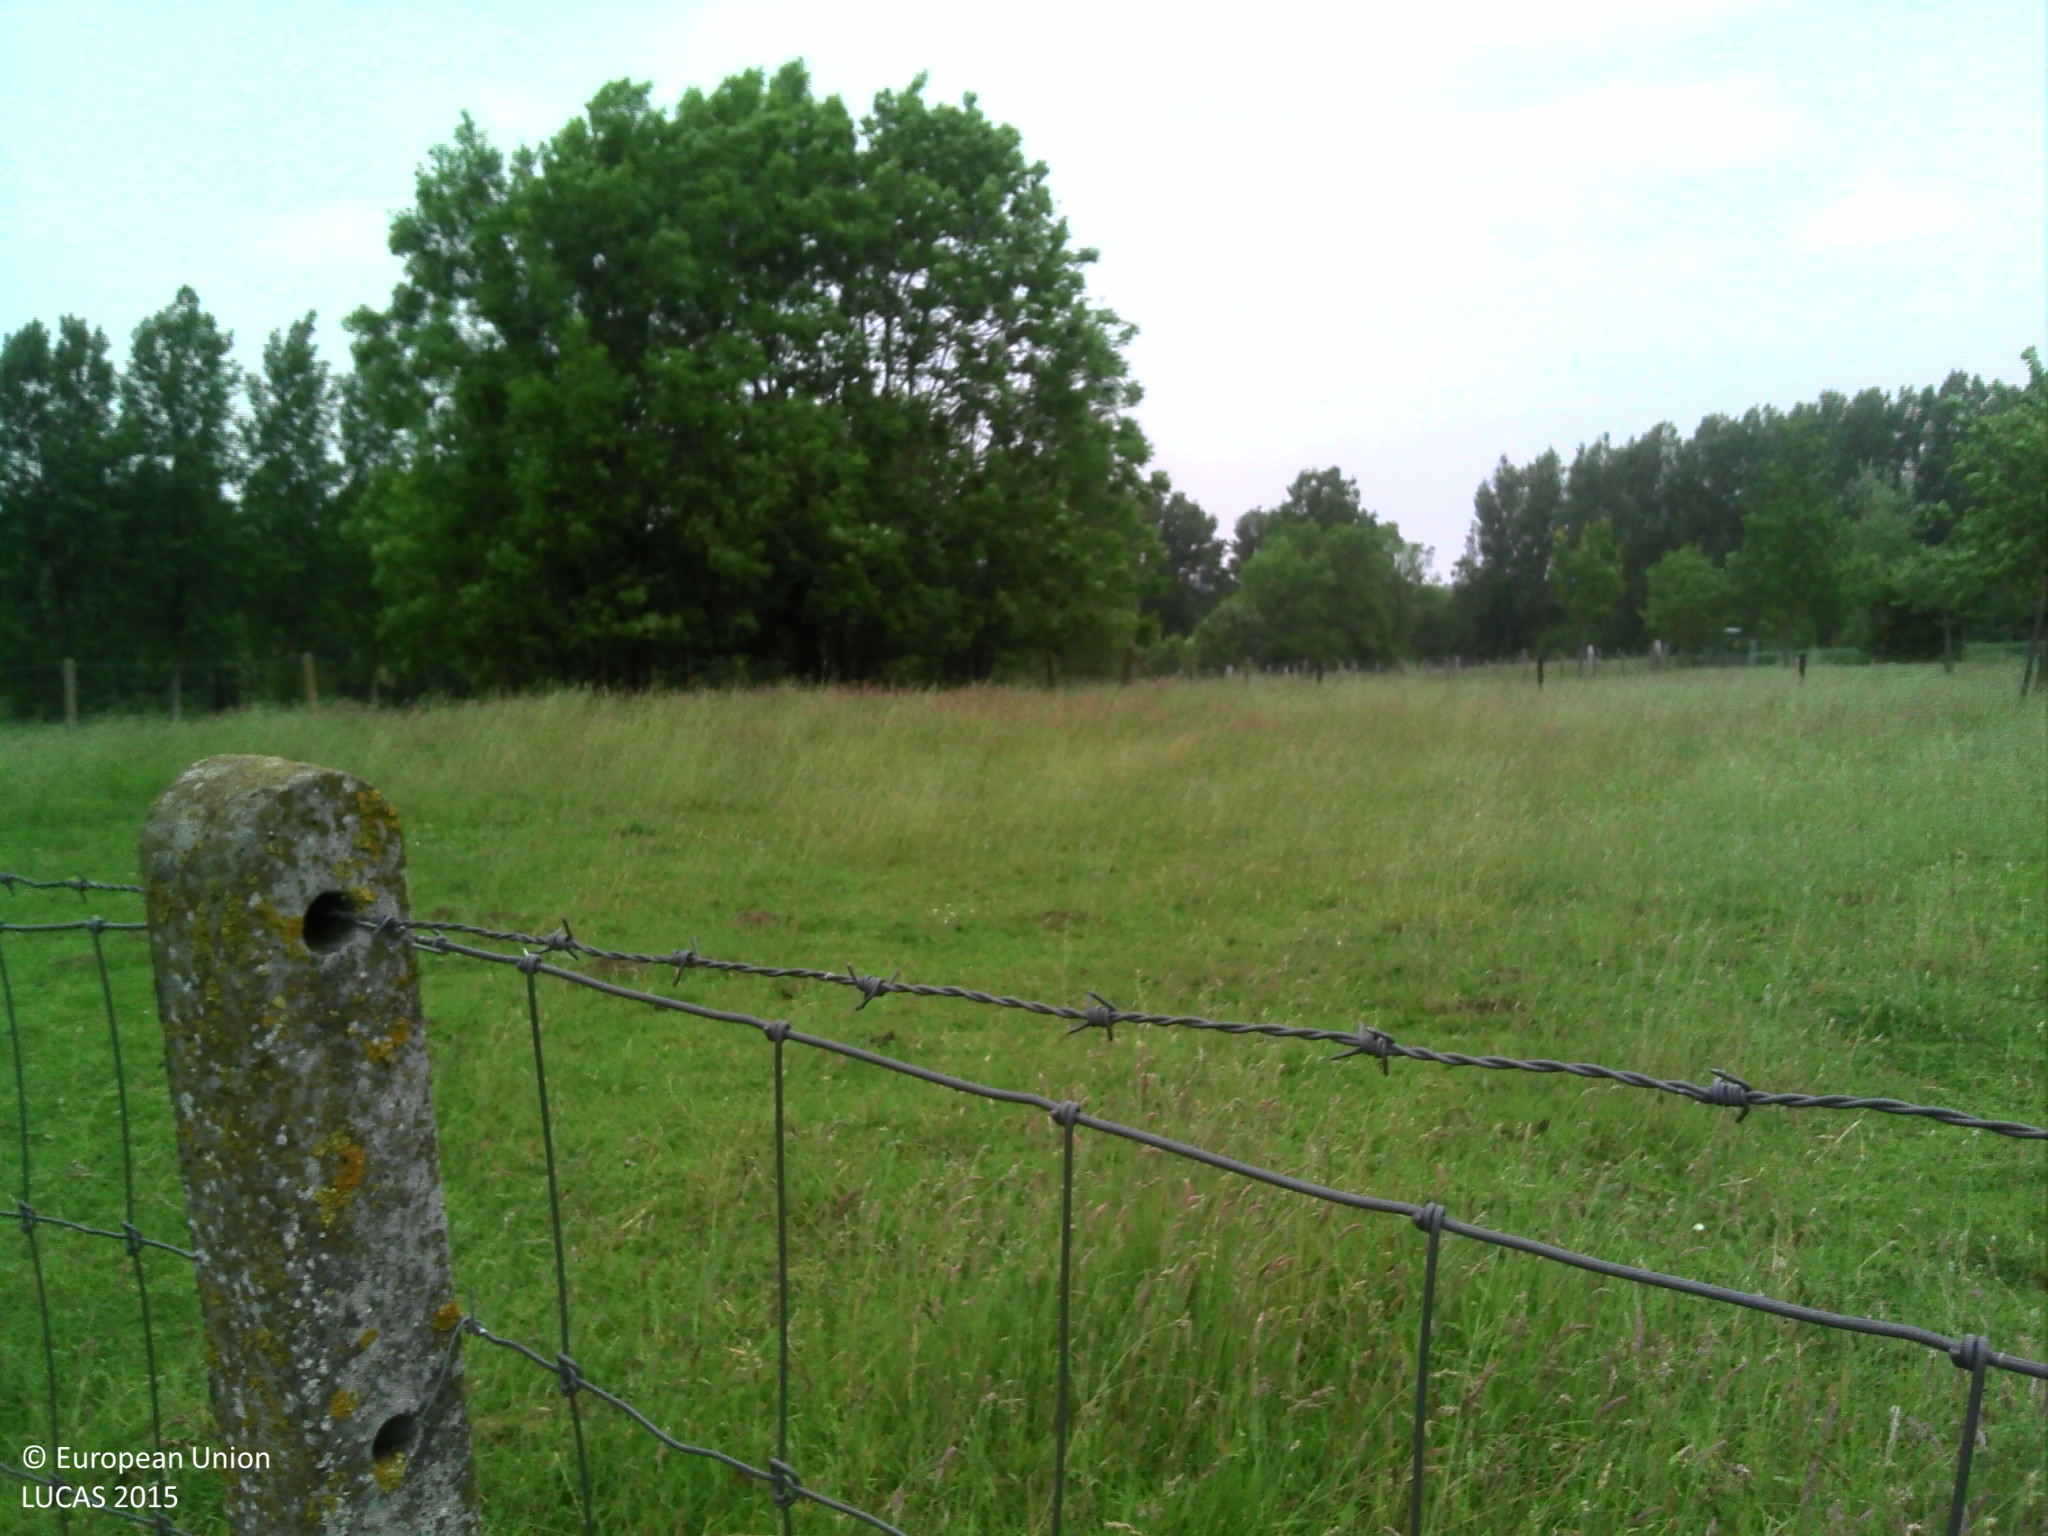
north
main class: Grassland
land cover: Grassland without tree/shrub cover
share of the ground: > 75 %
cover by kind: herbaceous plants 100 %
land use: Residential
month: June
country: BE
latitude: 50.8398
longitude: 3.7021
